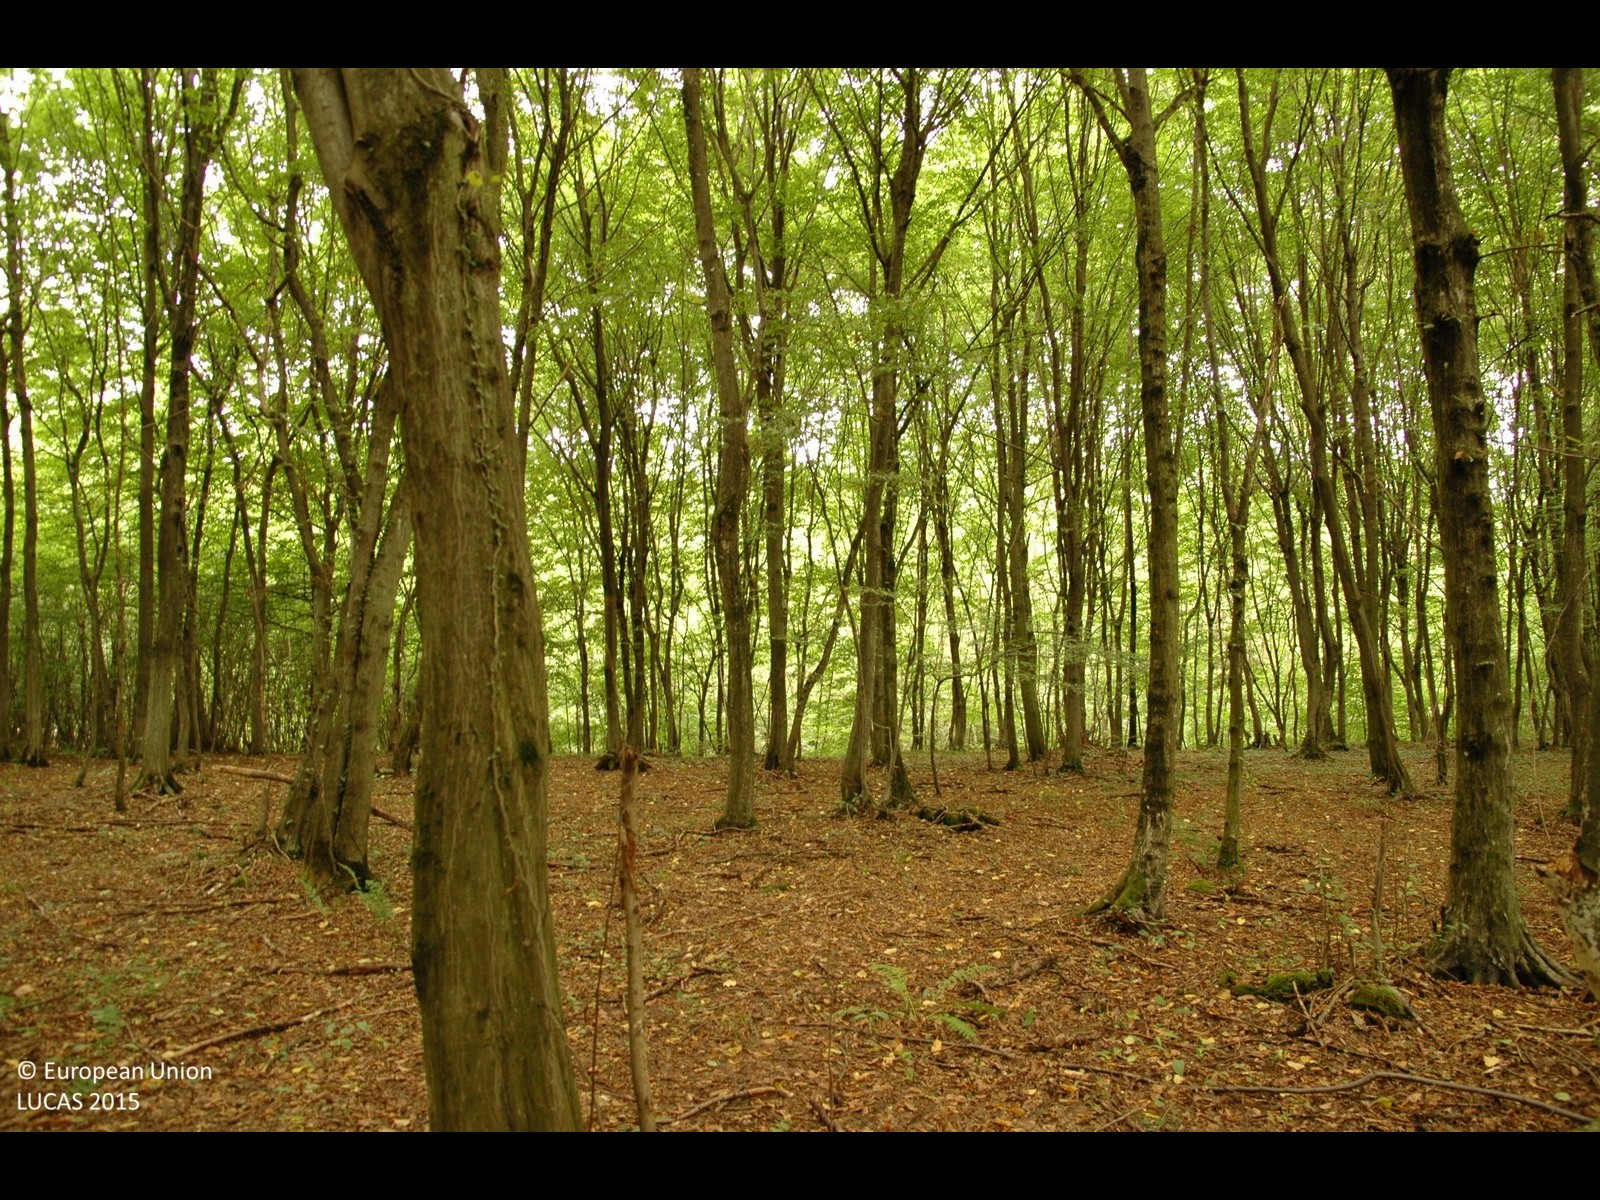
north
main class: Woodland
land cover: Broadleaved woodland
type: mesophytic deciduous forest
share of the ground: > 75 %
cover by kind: broadleaved forest trees 100 %
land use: Forestry
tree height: > 5 m
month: August
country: HR
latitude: 45.8526
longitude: 16.0897
